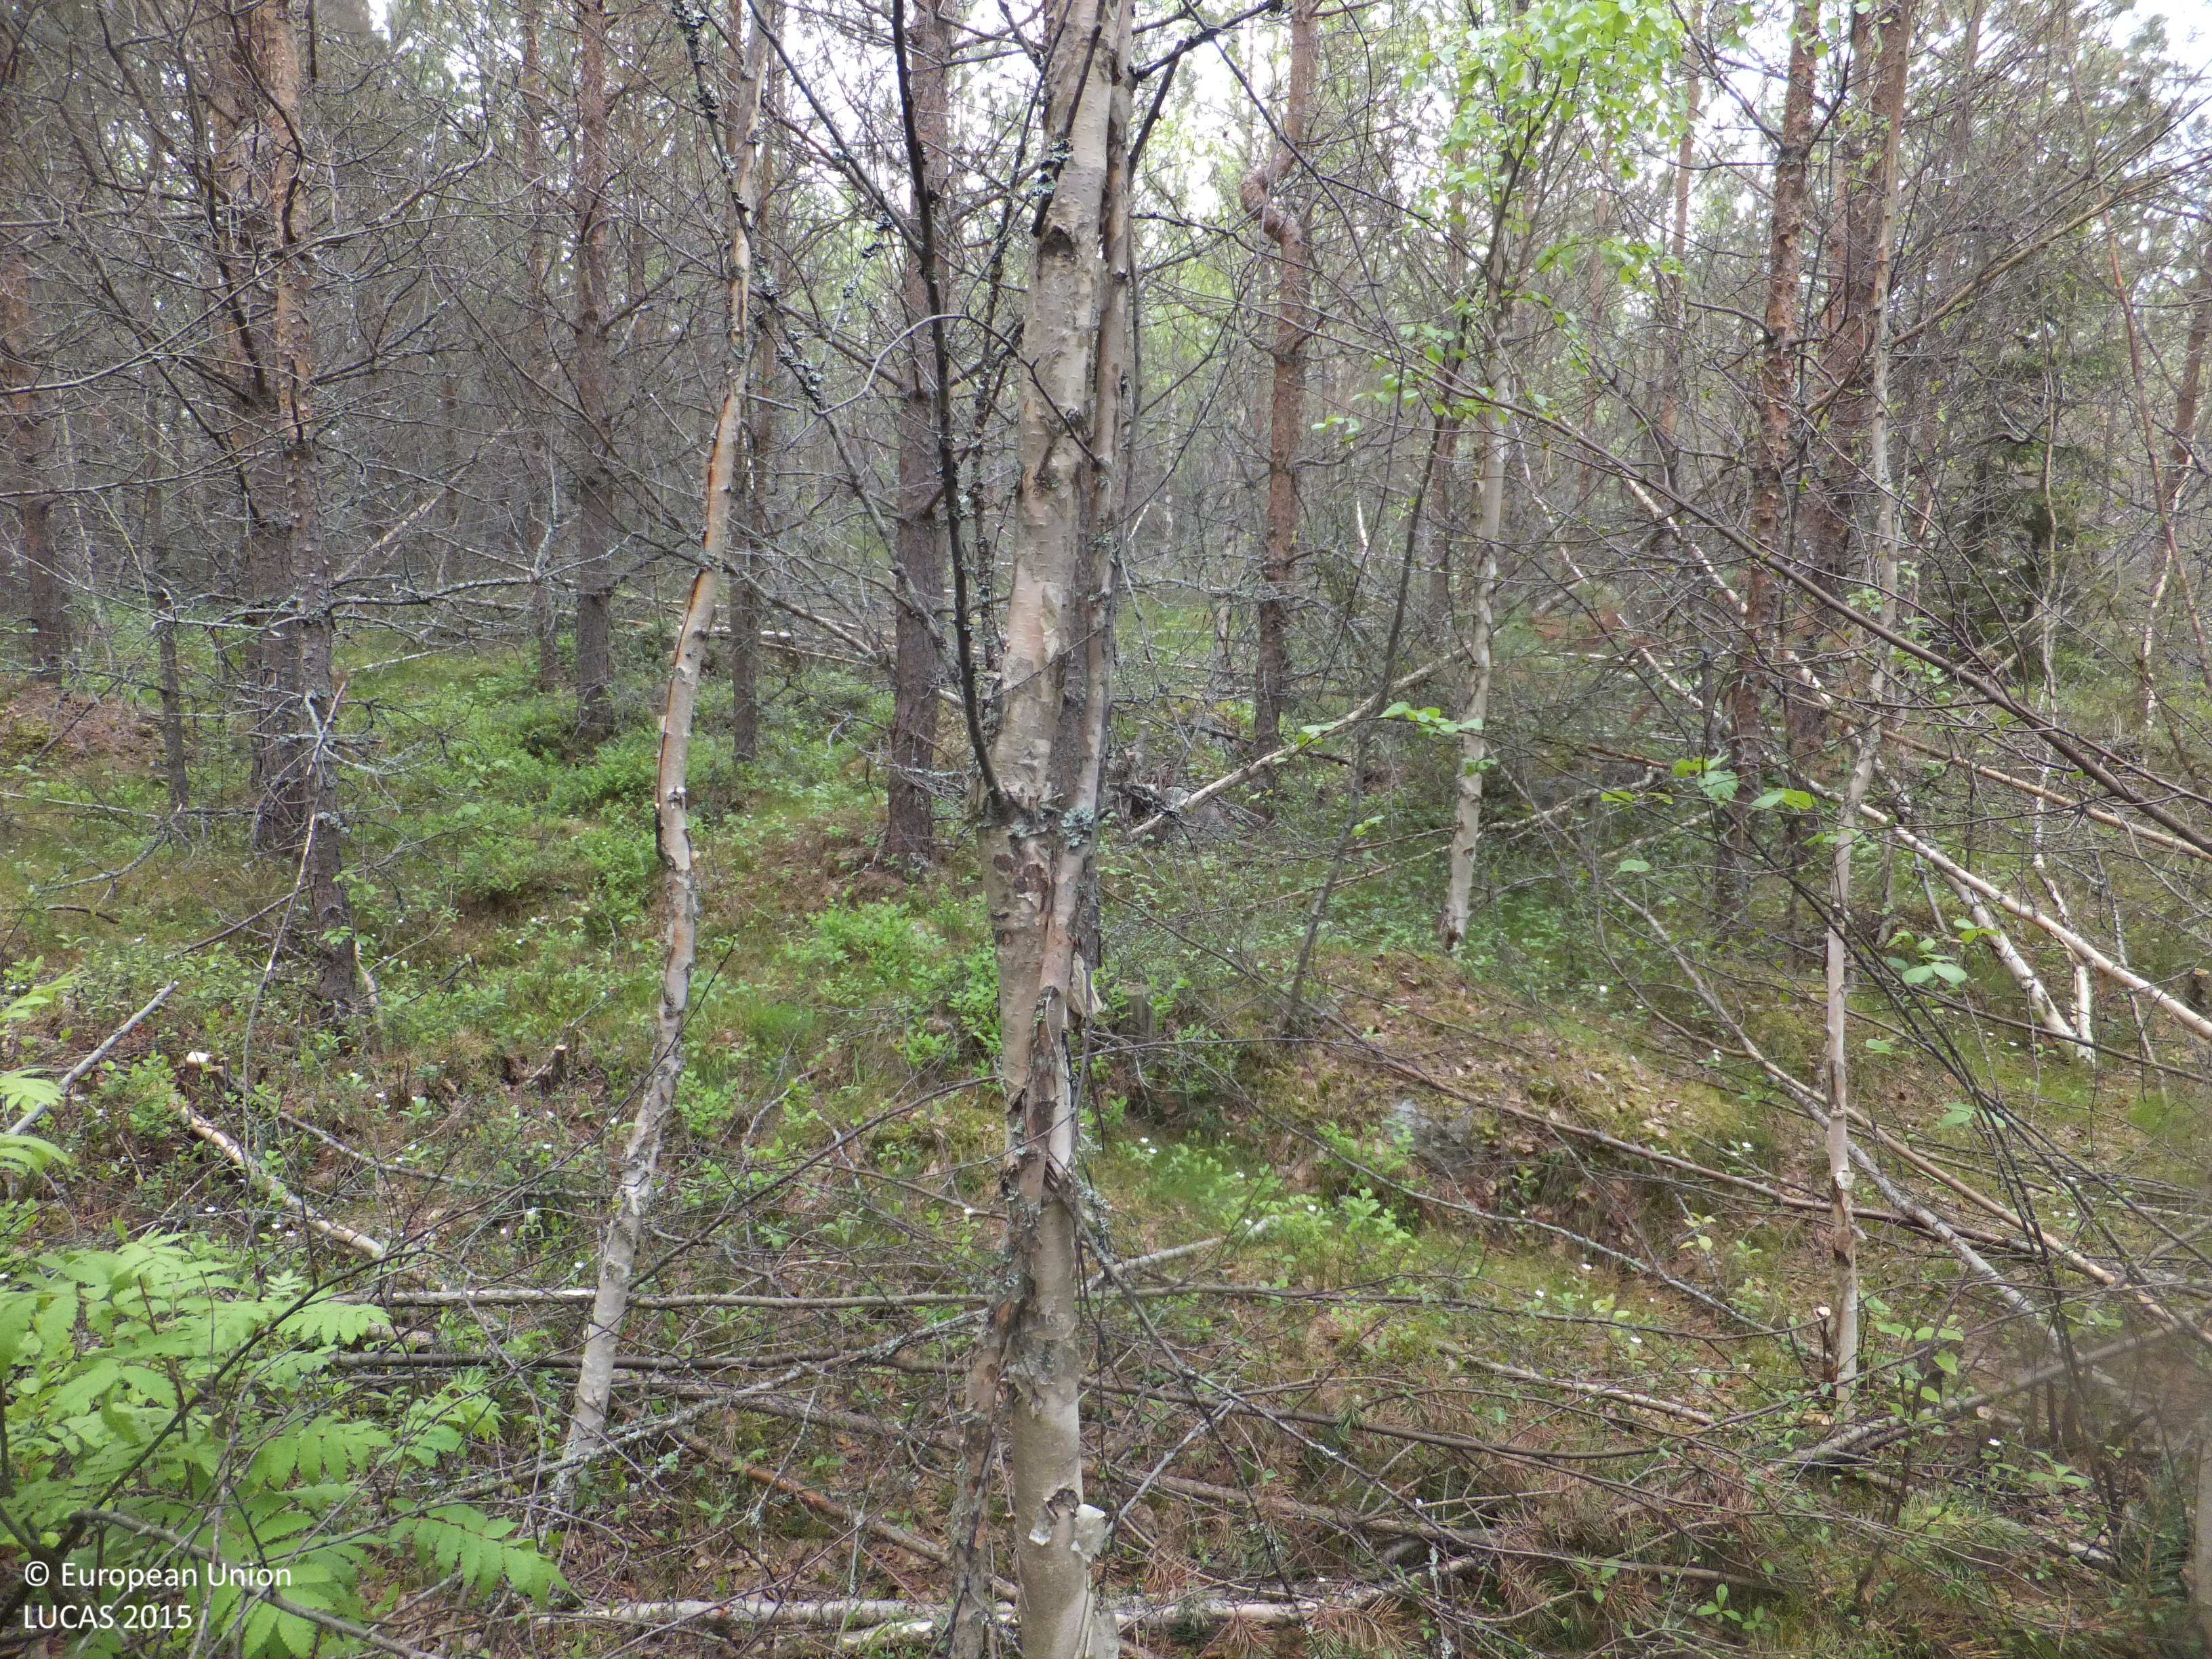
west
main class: Woodland
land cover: Pine dominated mixed woodland
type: boreal forest
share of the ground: > 75 %
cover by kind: coniferous forest trees 40 %, broadleaved forest trees 35 %, shrubs 10 %, herbaceous plants 10 %, lichens and mosses 5 %
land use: Forestry
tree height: > 5 m
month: June
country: FI
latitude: 63.3538
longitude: 22.7023
